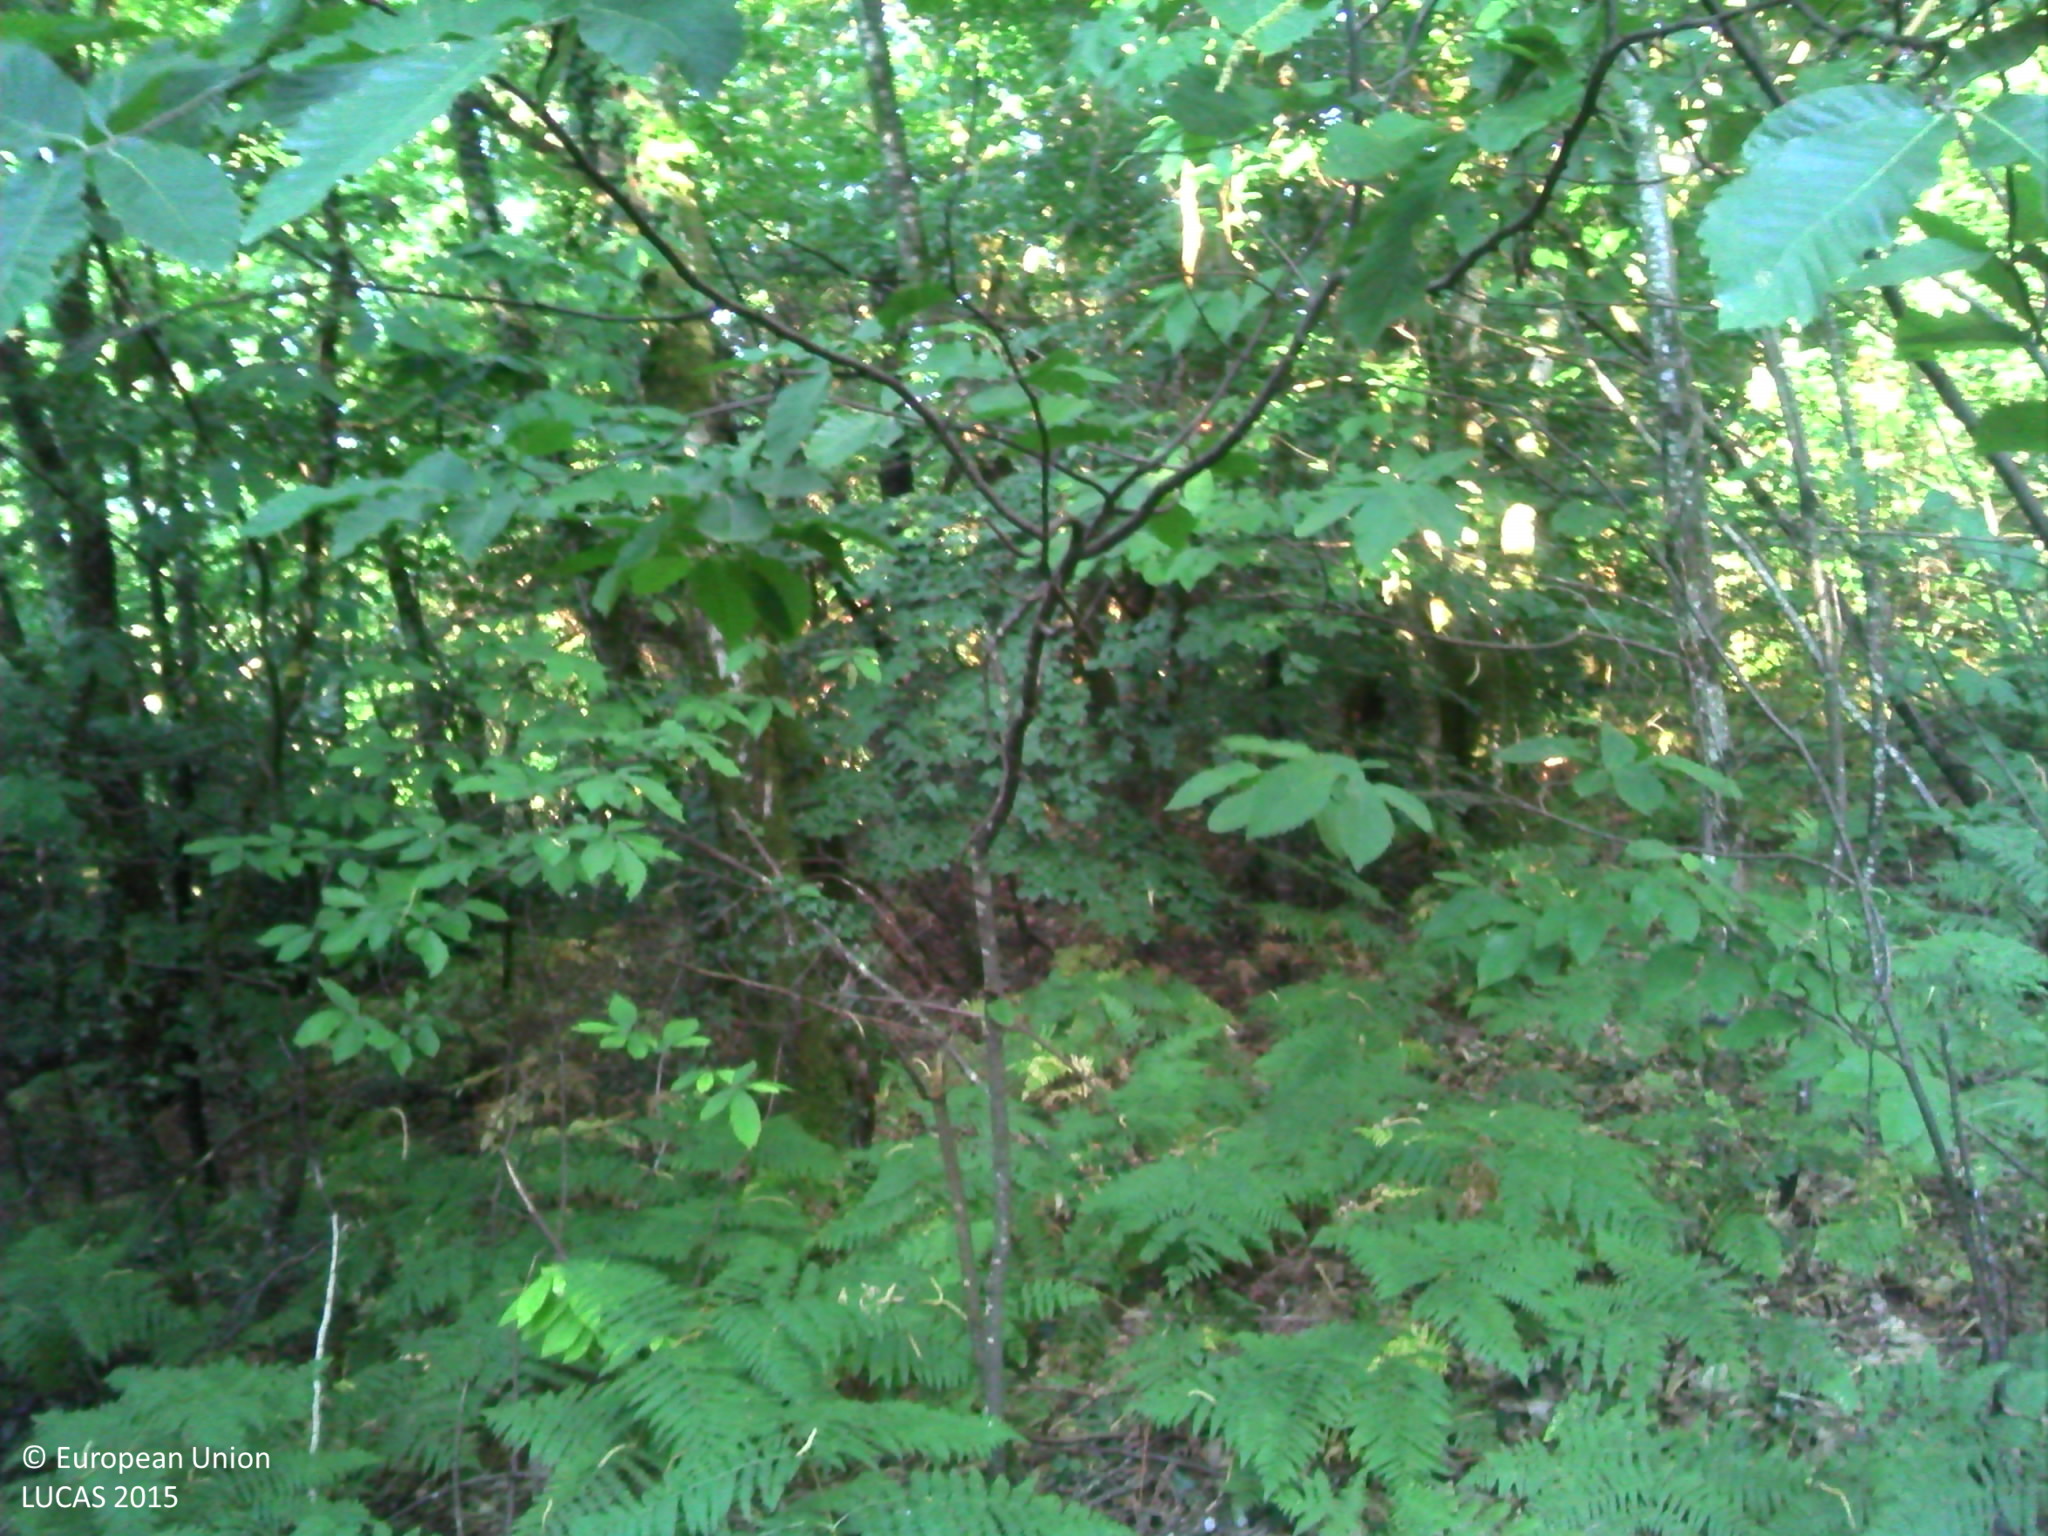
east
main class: Woodland
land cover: Broadleaved woodland
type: mesophytic deciduous forest
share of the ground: > 75 %
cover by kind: broadleaved forest trees 80 %, shrubs 10 %, herbaceous plants 10 %
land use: Forestry
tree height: > 5 m
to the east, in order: Broadleaved woodland; Dry stone walls; Broadleaved woodland; Spontaneously vegetated surfaces; Grassland without tree/shrub cover
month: July
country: FR
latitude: 46.2157
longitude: 1.5522
